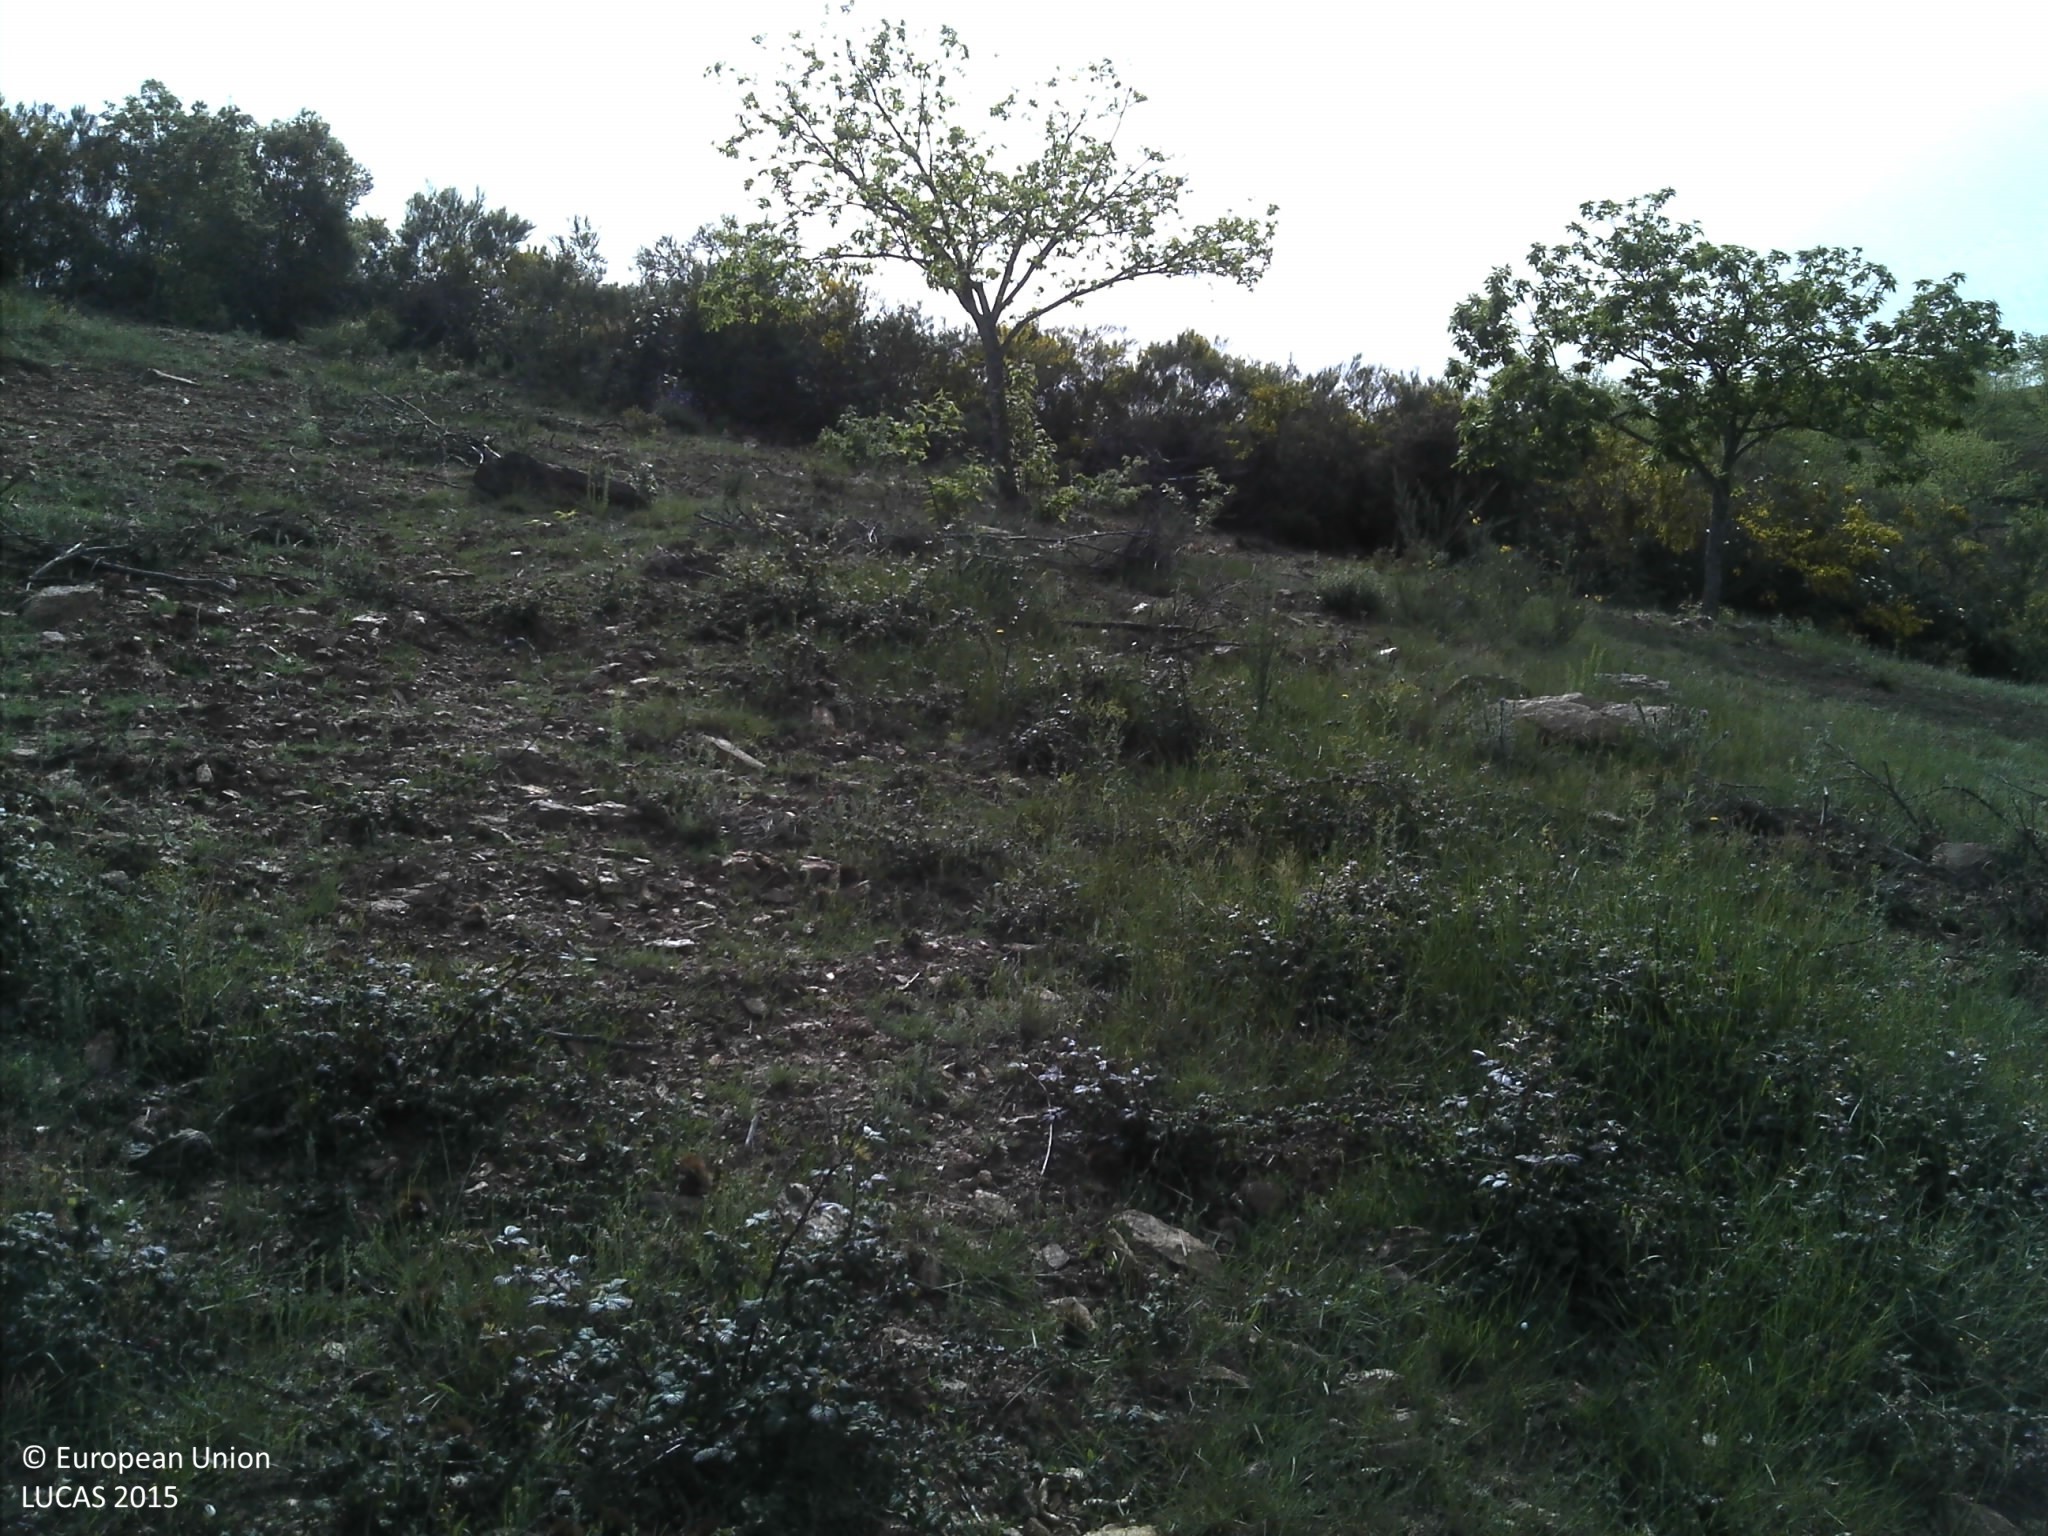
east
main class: Cropland
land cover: Nuts trees
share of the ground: 10 - 25 %
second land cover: Grassland without tree/shrub cover
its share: 10 - 25 %
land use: Agriculture (excluding fallow land and kitchen gardens)
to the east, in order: Nuts trees; Grassland without tree/shrub cover; Shrubland with sparse tree cover; Other bare soil; Nuts trees; Shruby margins; Grass margins; Tracks; Nuts trees; Broadleaved woodland; Nuts trees
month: May
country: PT
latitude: 41.8379
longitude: -7.0647
